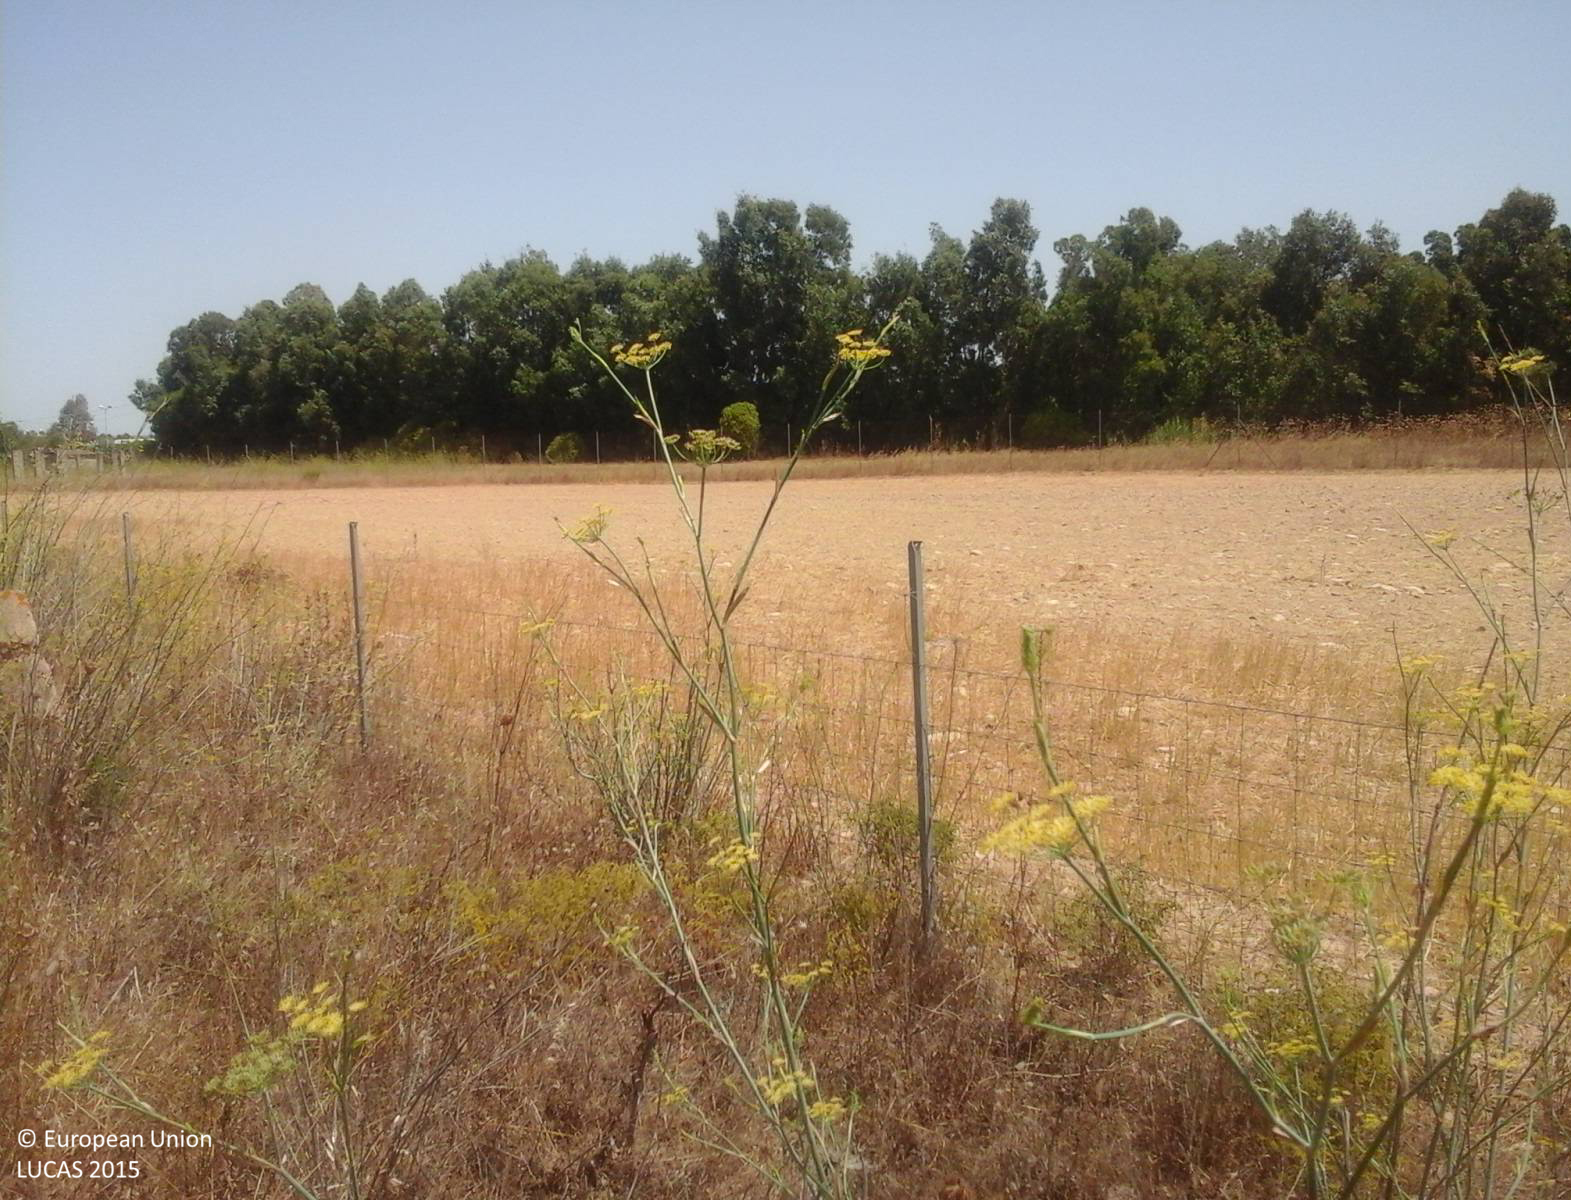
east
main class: Cropland
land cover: Temporary grasslands
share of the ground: > 75 %
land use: Agriculture (excluding fallow land and kitchen gardens)
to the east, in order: Temporary grasslands; Fences; Grassland without tree/shrub cover; Broadleaved woodland; Other citrus fruit; Fences; Tracks; Broadleaved woodland; Arable land (only in case pi)
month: August
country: IT
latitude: 39.4094
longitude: 8.8571
